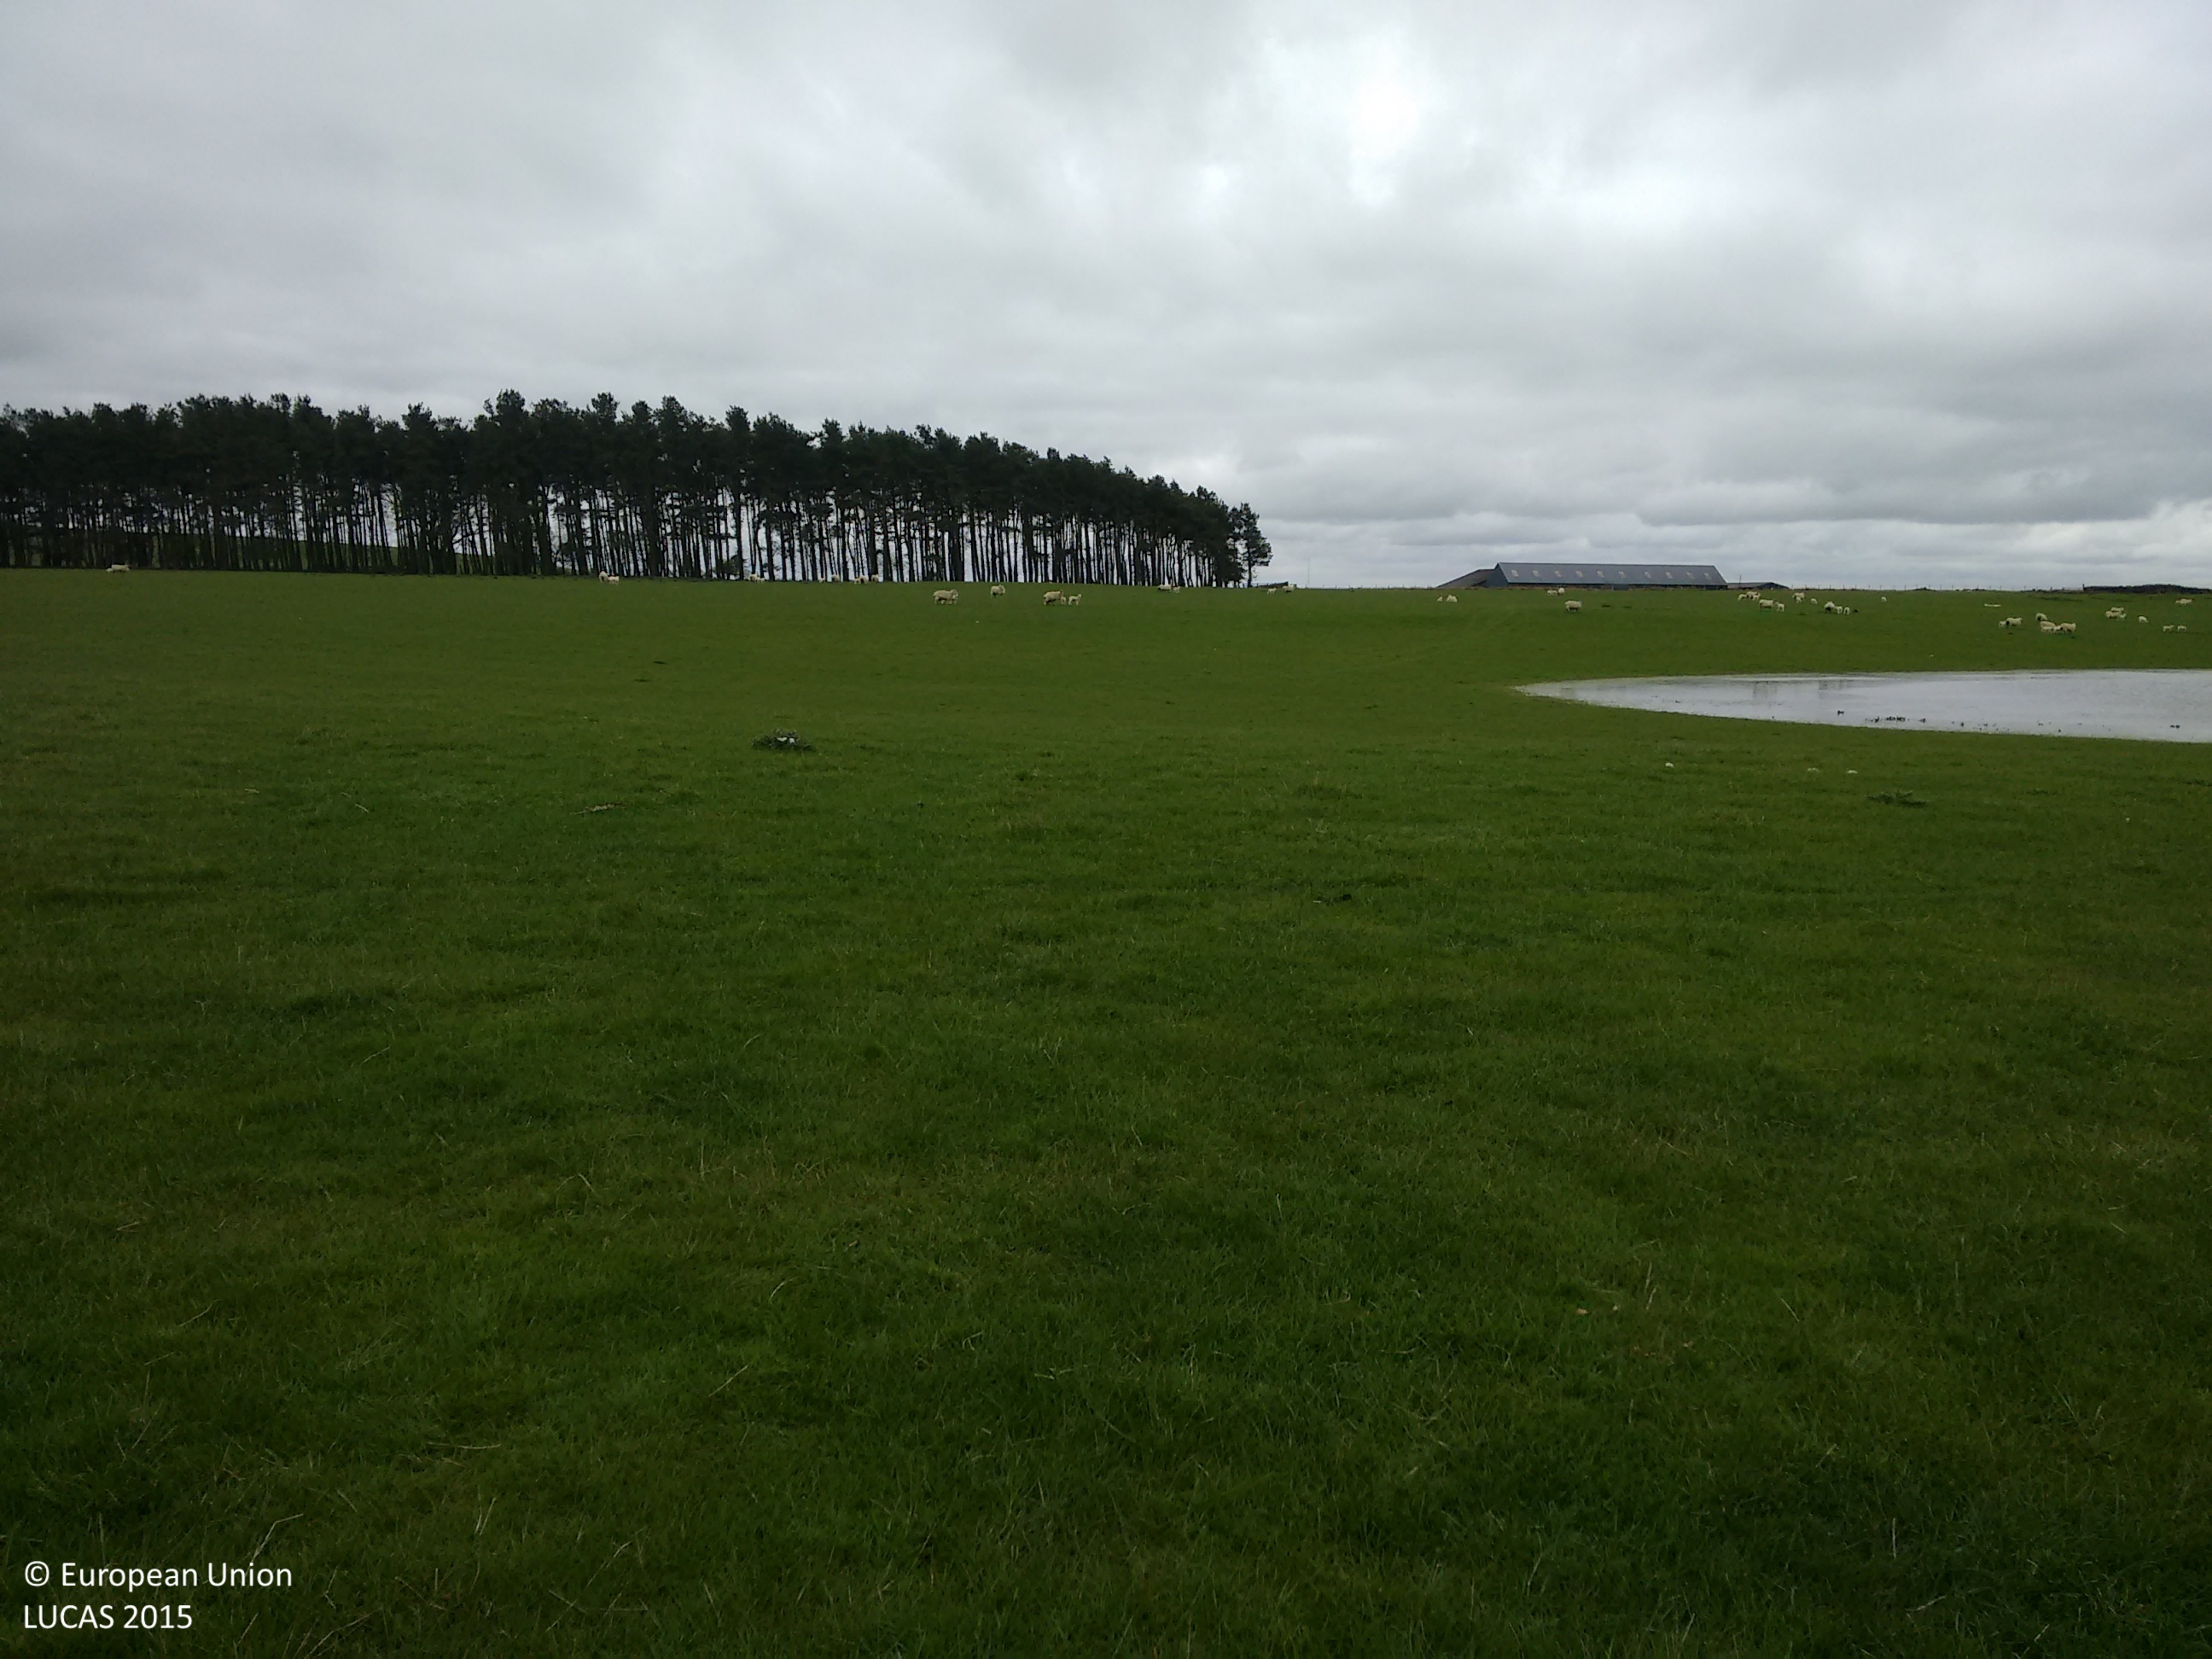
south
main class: Grassland
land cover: Grassland without tree/shrub cover
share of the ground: > 75 %
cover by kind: herbaceous plants 100 %
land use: Agriculture (excluding fallow land and kitchen gardens)
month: May
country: GB
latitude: 55.0935
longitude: -2.0103
